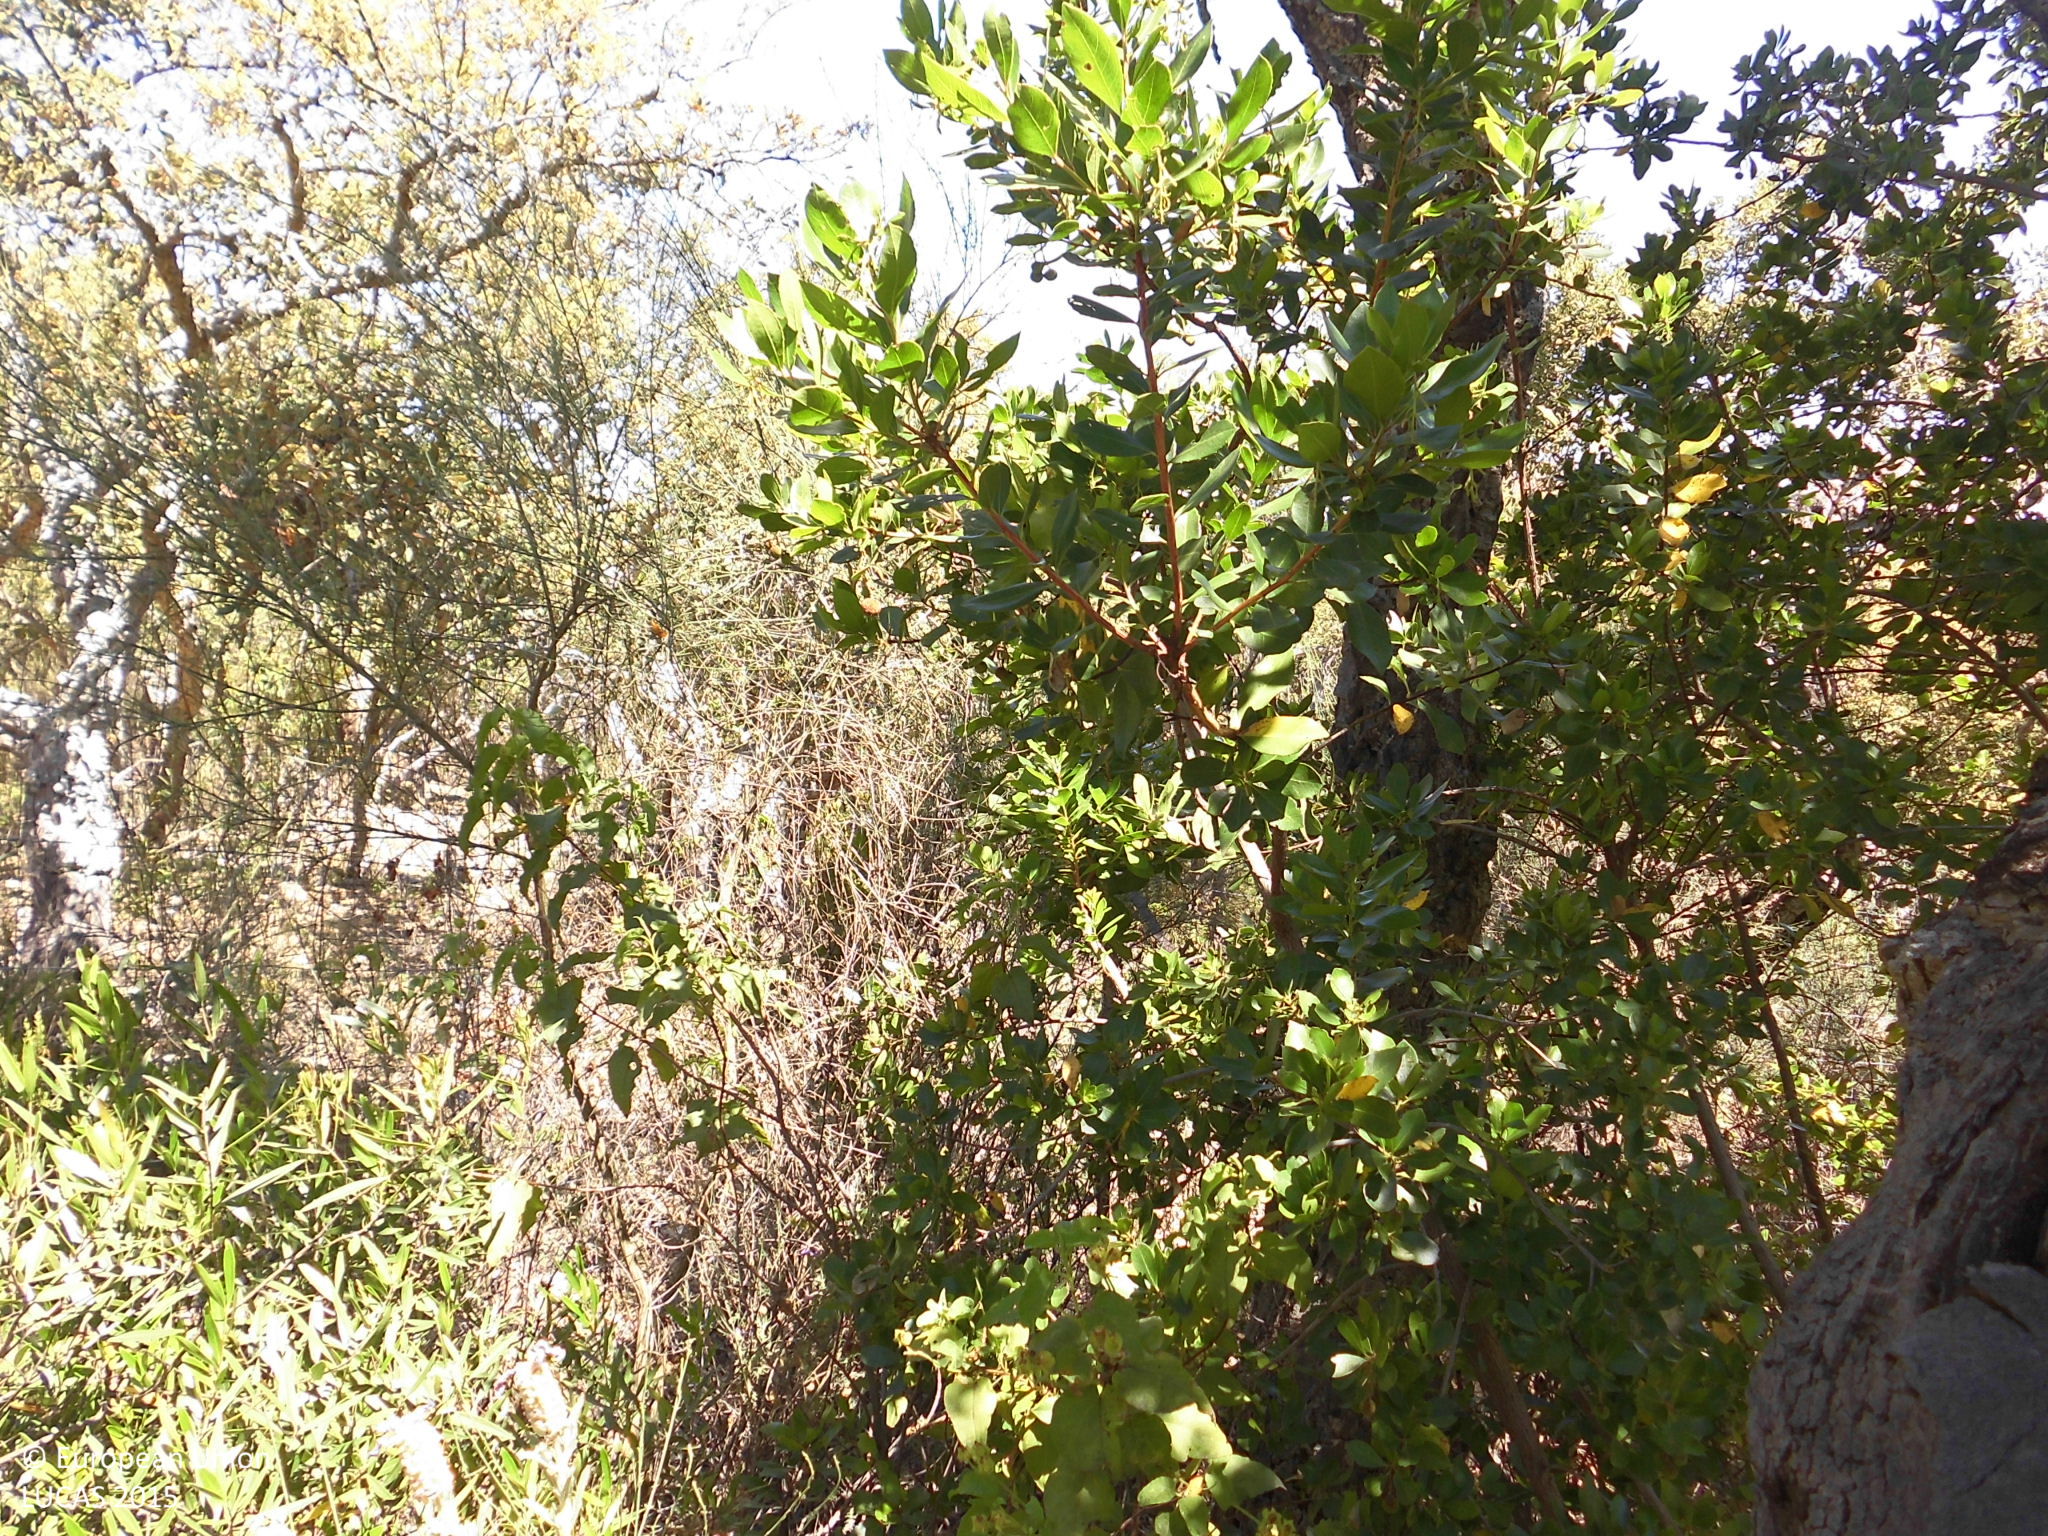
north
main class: Woodland
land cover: Broadleaved woodland
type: broadleaved evergreen forest
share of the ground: > 75 %
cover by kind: broadleaved forest trees 75 %, shrubs 25 %
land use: Forestry
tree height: > 5 m
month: May
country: ES
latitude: 39.4434
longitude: -7.0582
